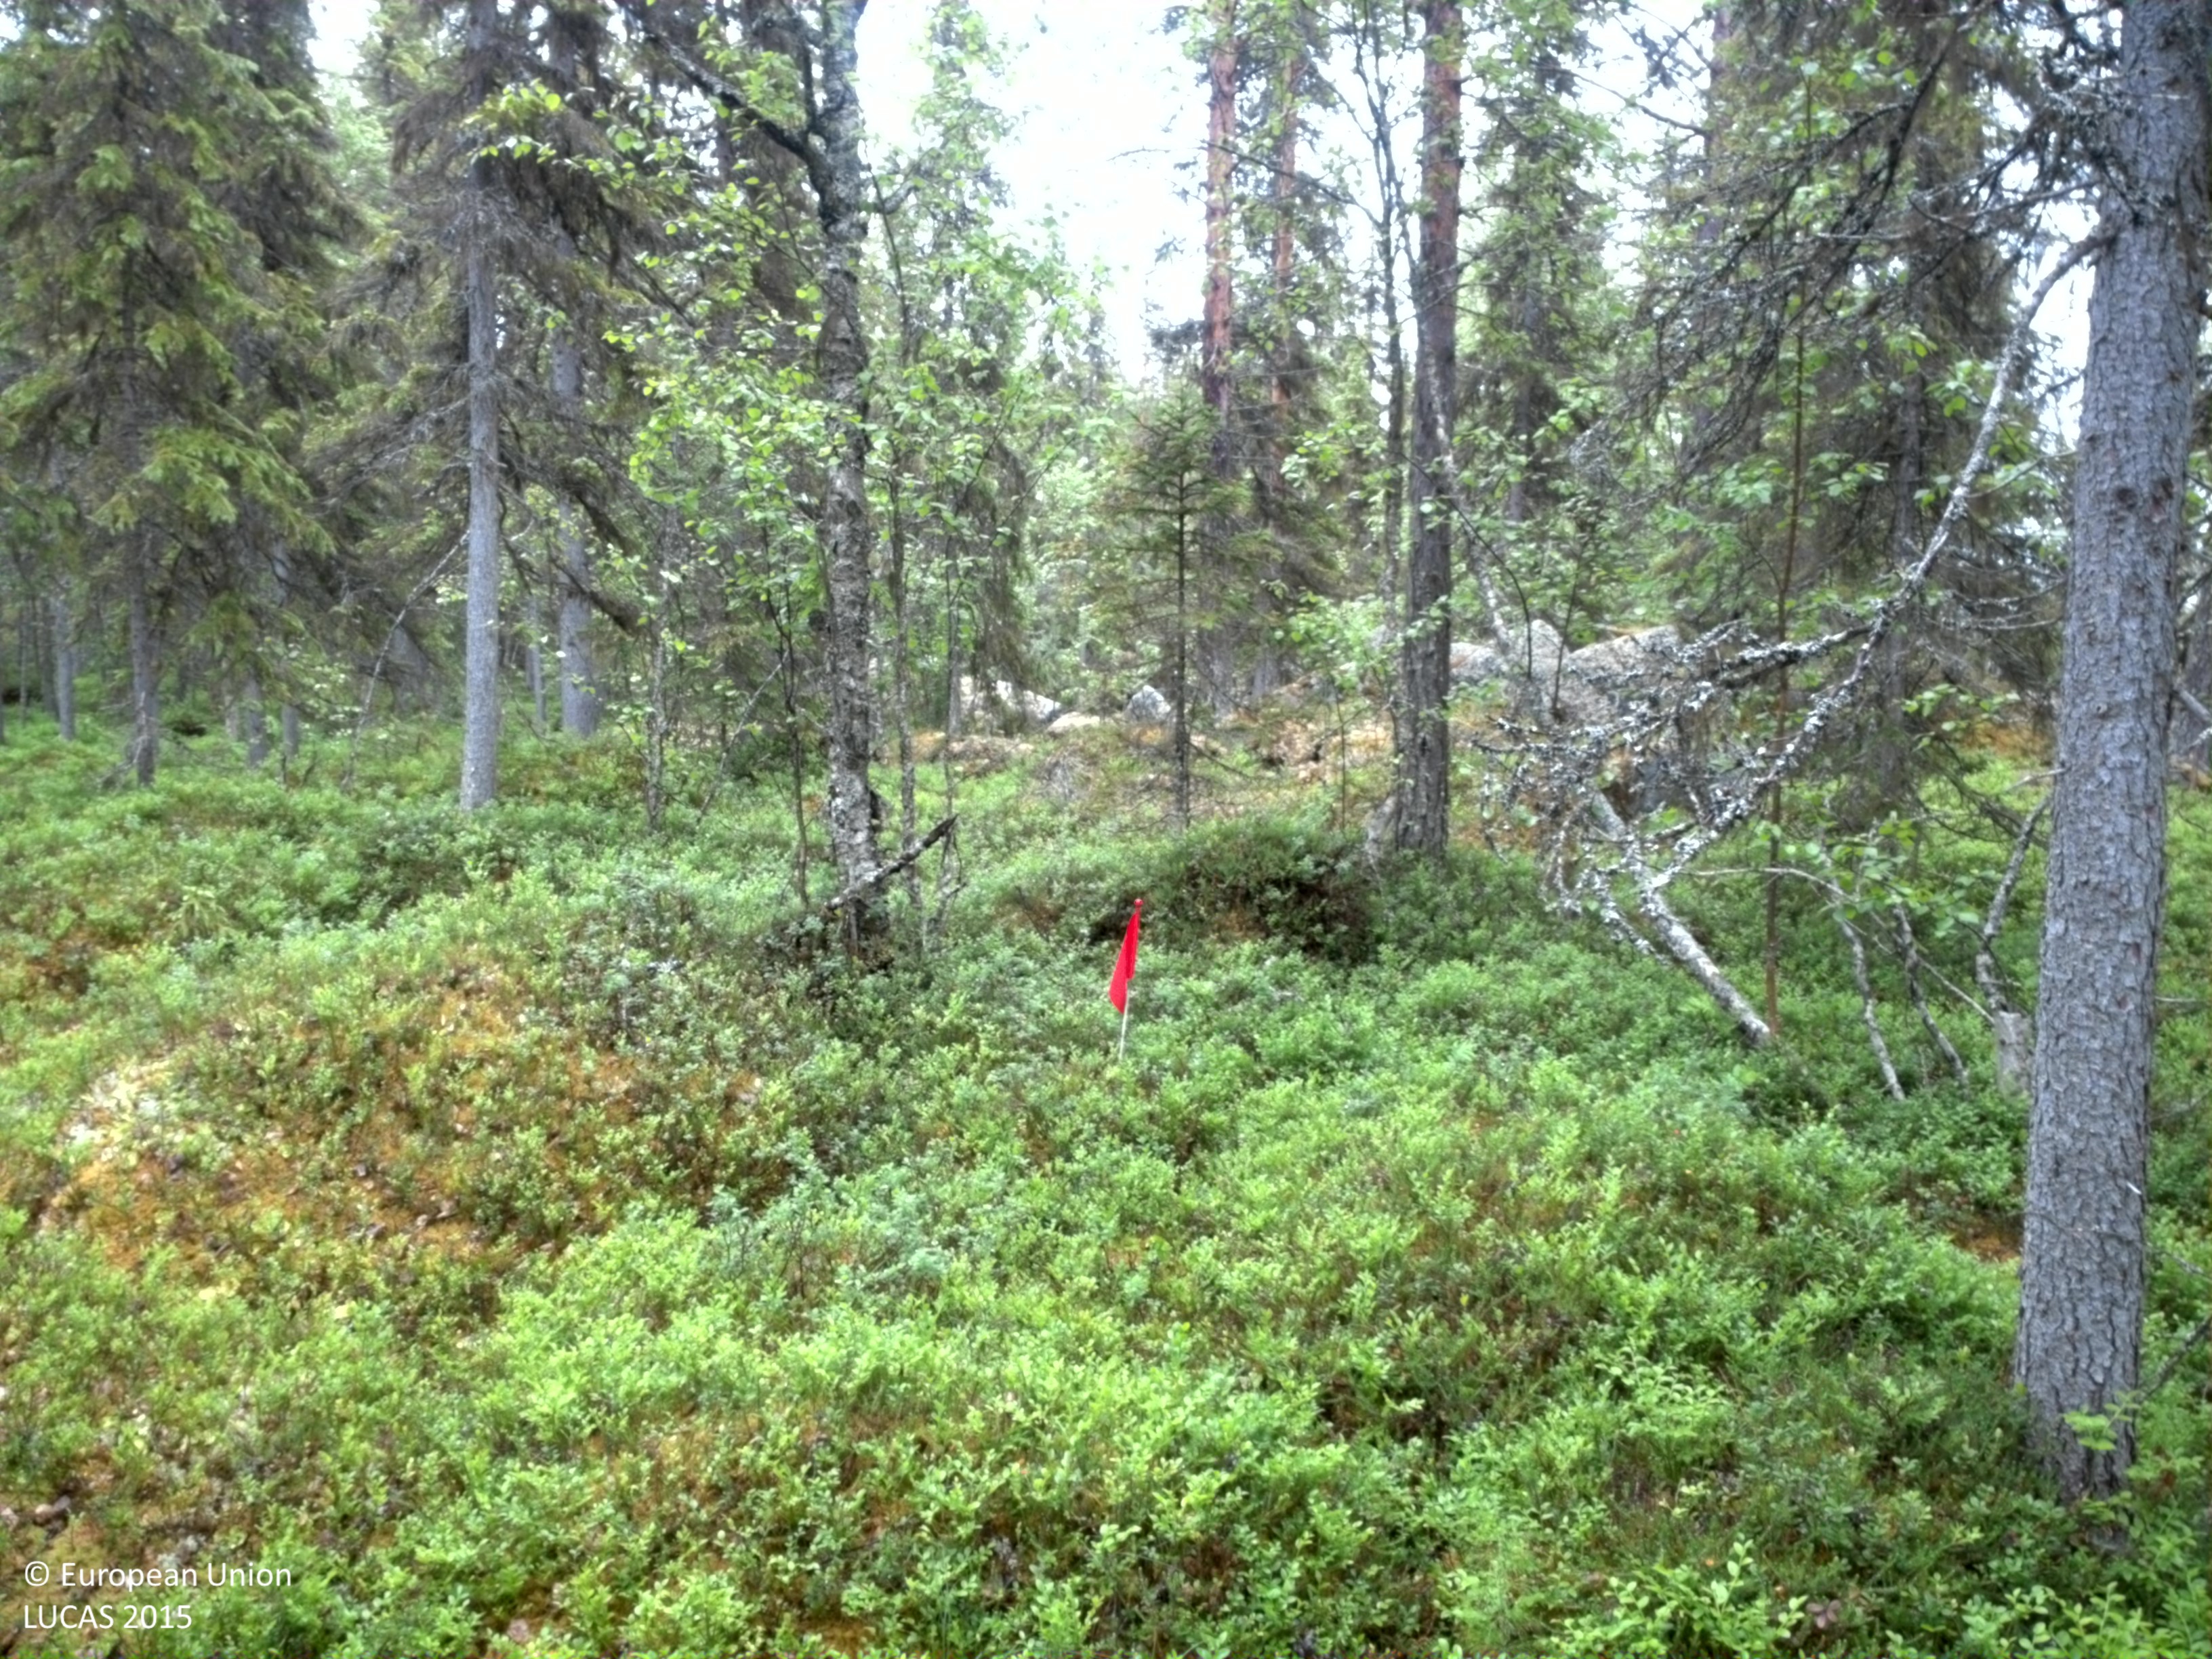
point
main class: Woodland
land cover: Other coniferous woodland
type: boreal forest
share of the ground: 25 - 50 %
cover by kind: coniferous forest trees 45 %, shrubs 40 %, lichens and mosses 10 %, broadleaved forest trees 5 %
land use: Forestry
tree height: > 5 m
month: July
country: SE
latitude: 64.6007
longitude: 18.2626
